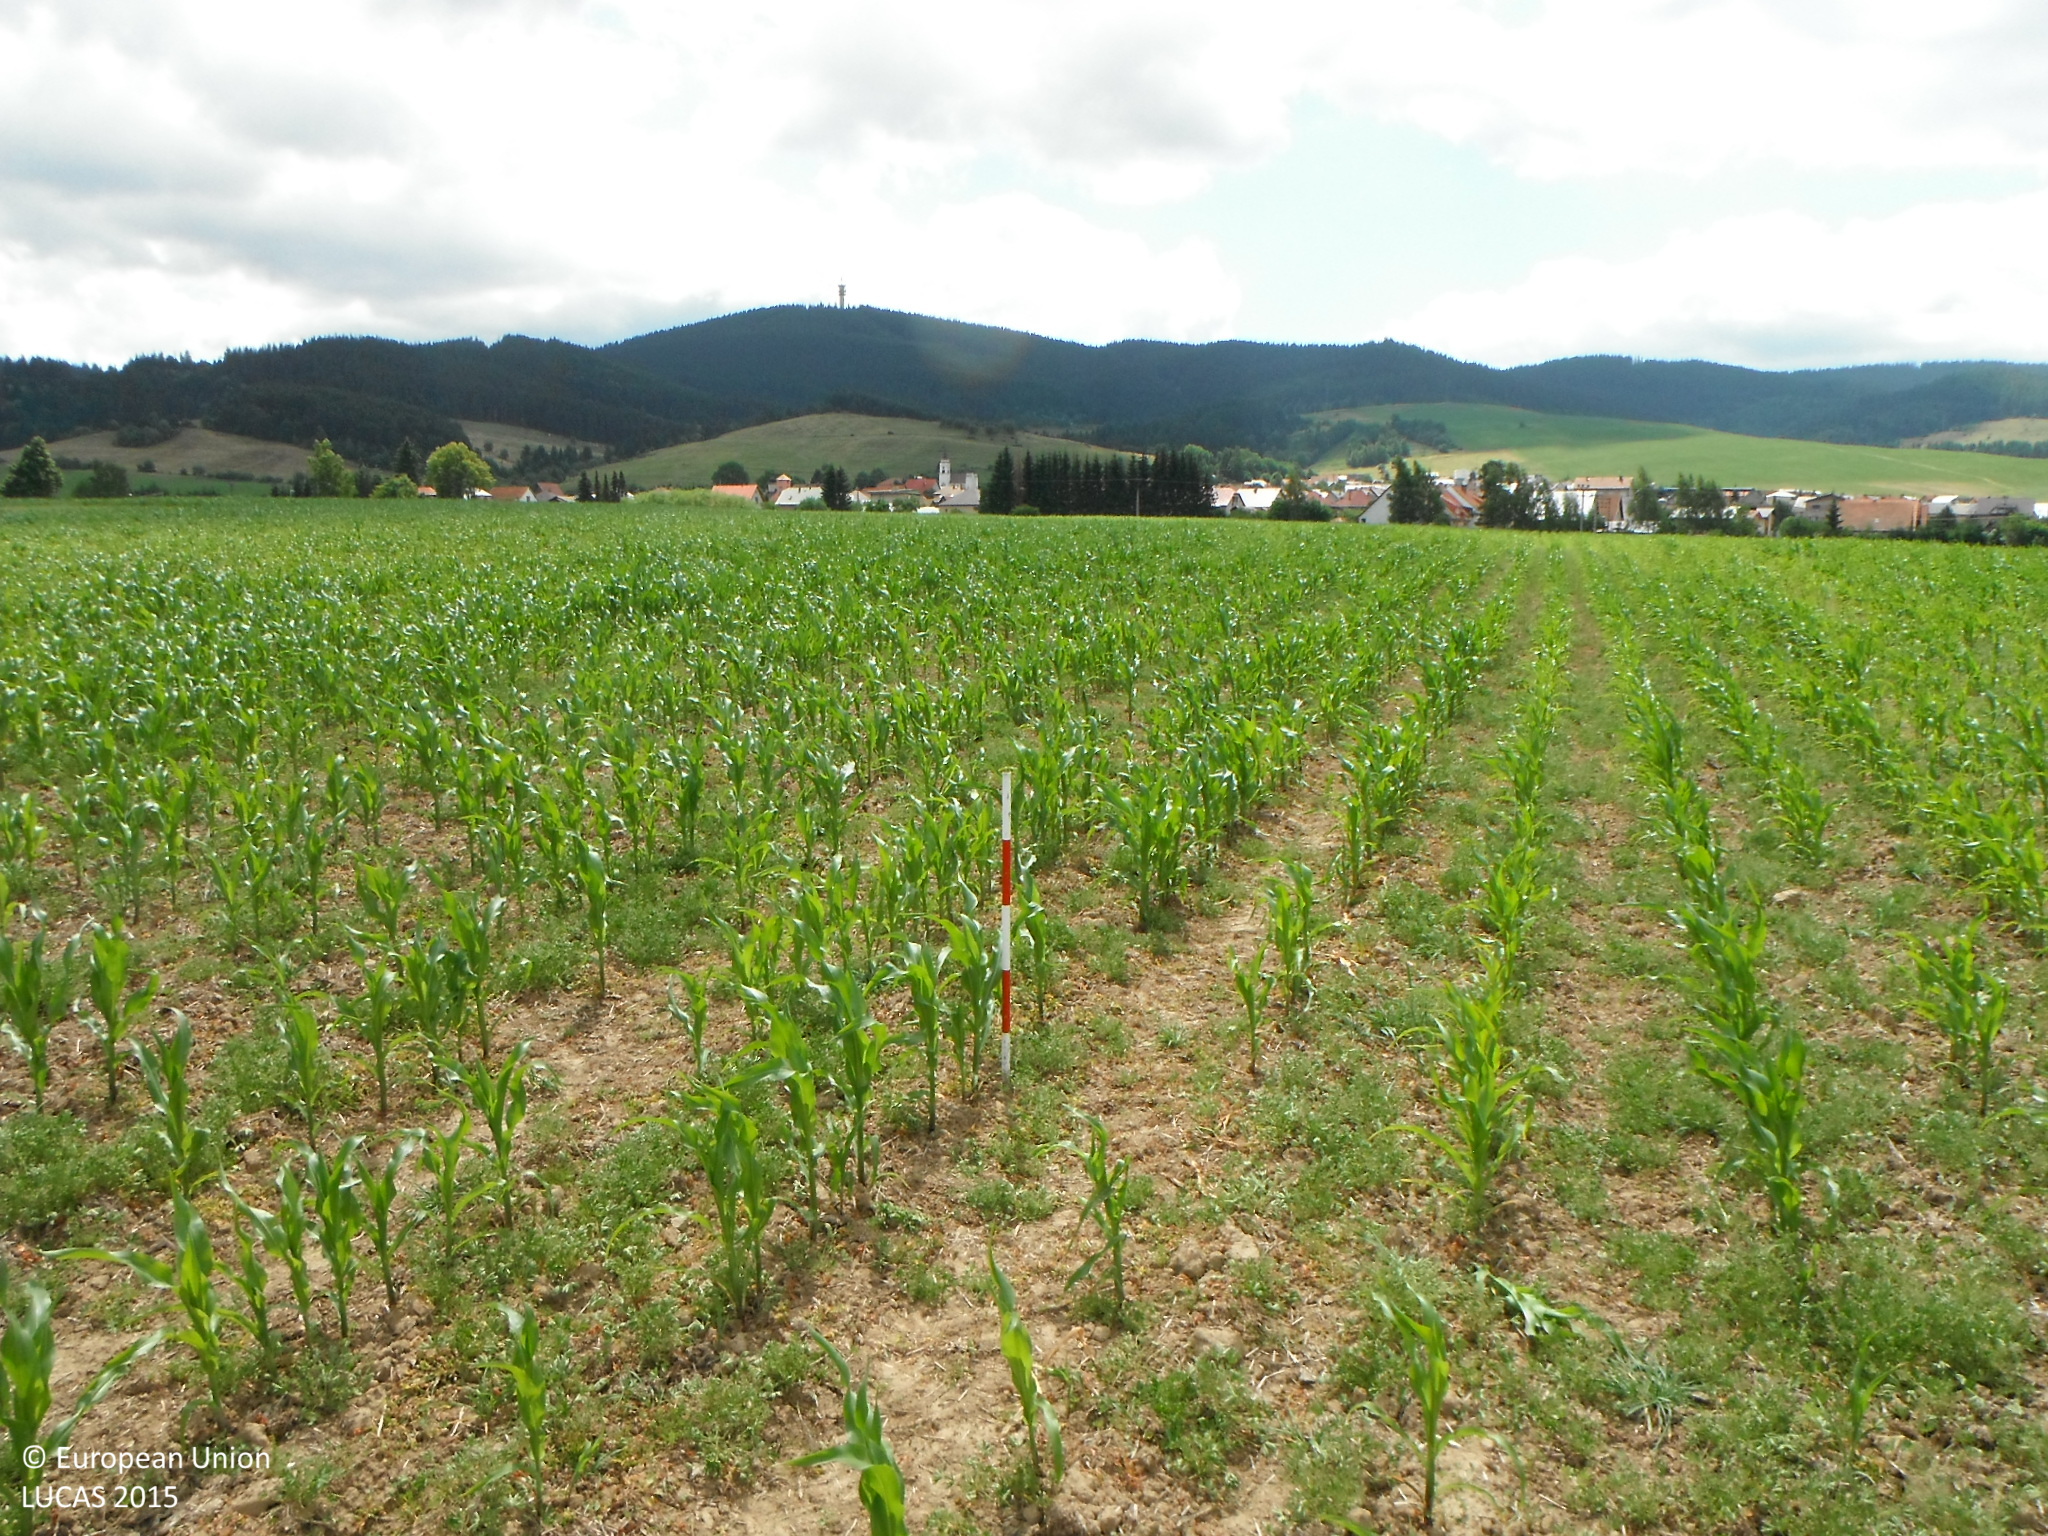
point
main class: Cropland
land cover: Maize
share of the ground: 25 - 50 %
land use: Agriculture (excluding fallow land and kitchen gardens)
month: July
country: SK
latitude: 49.3914
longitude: 19.4637
